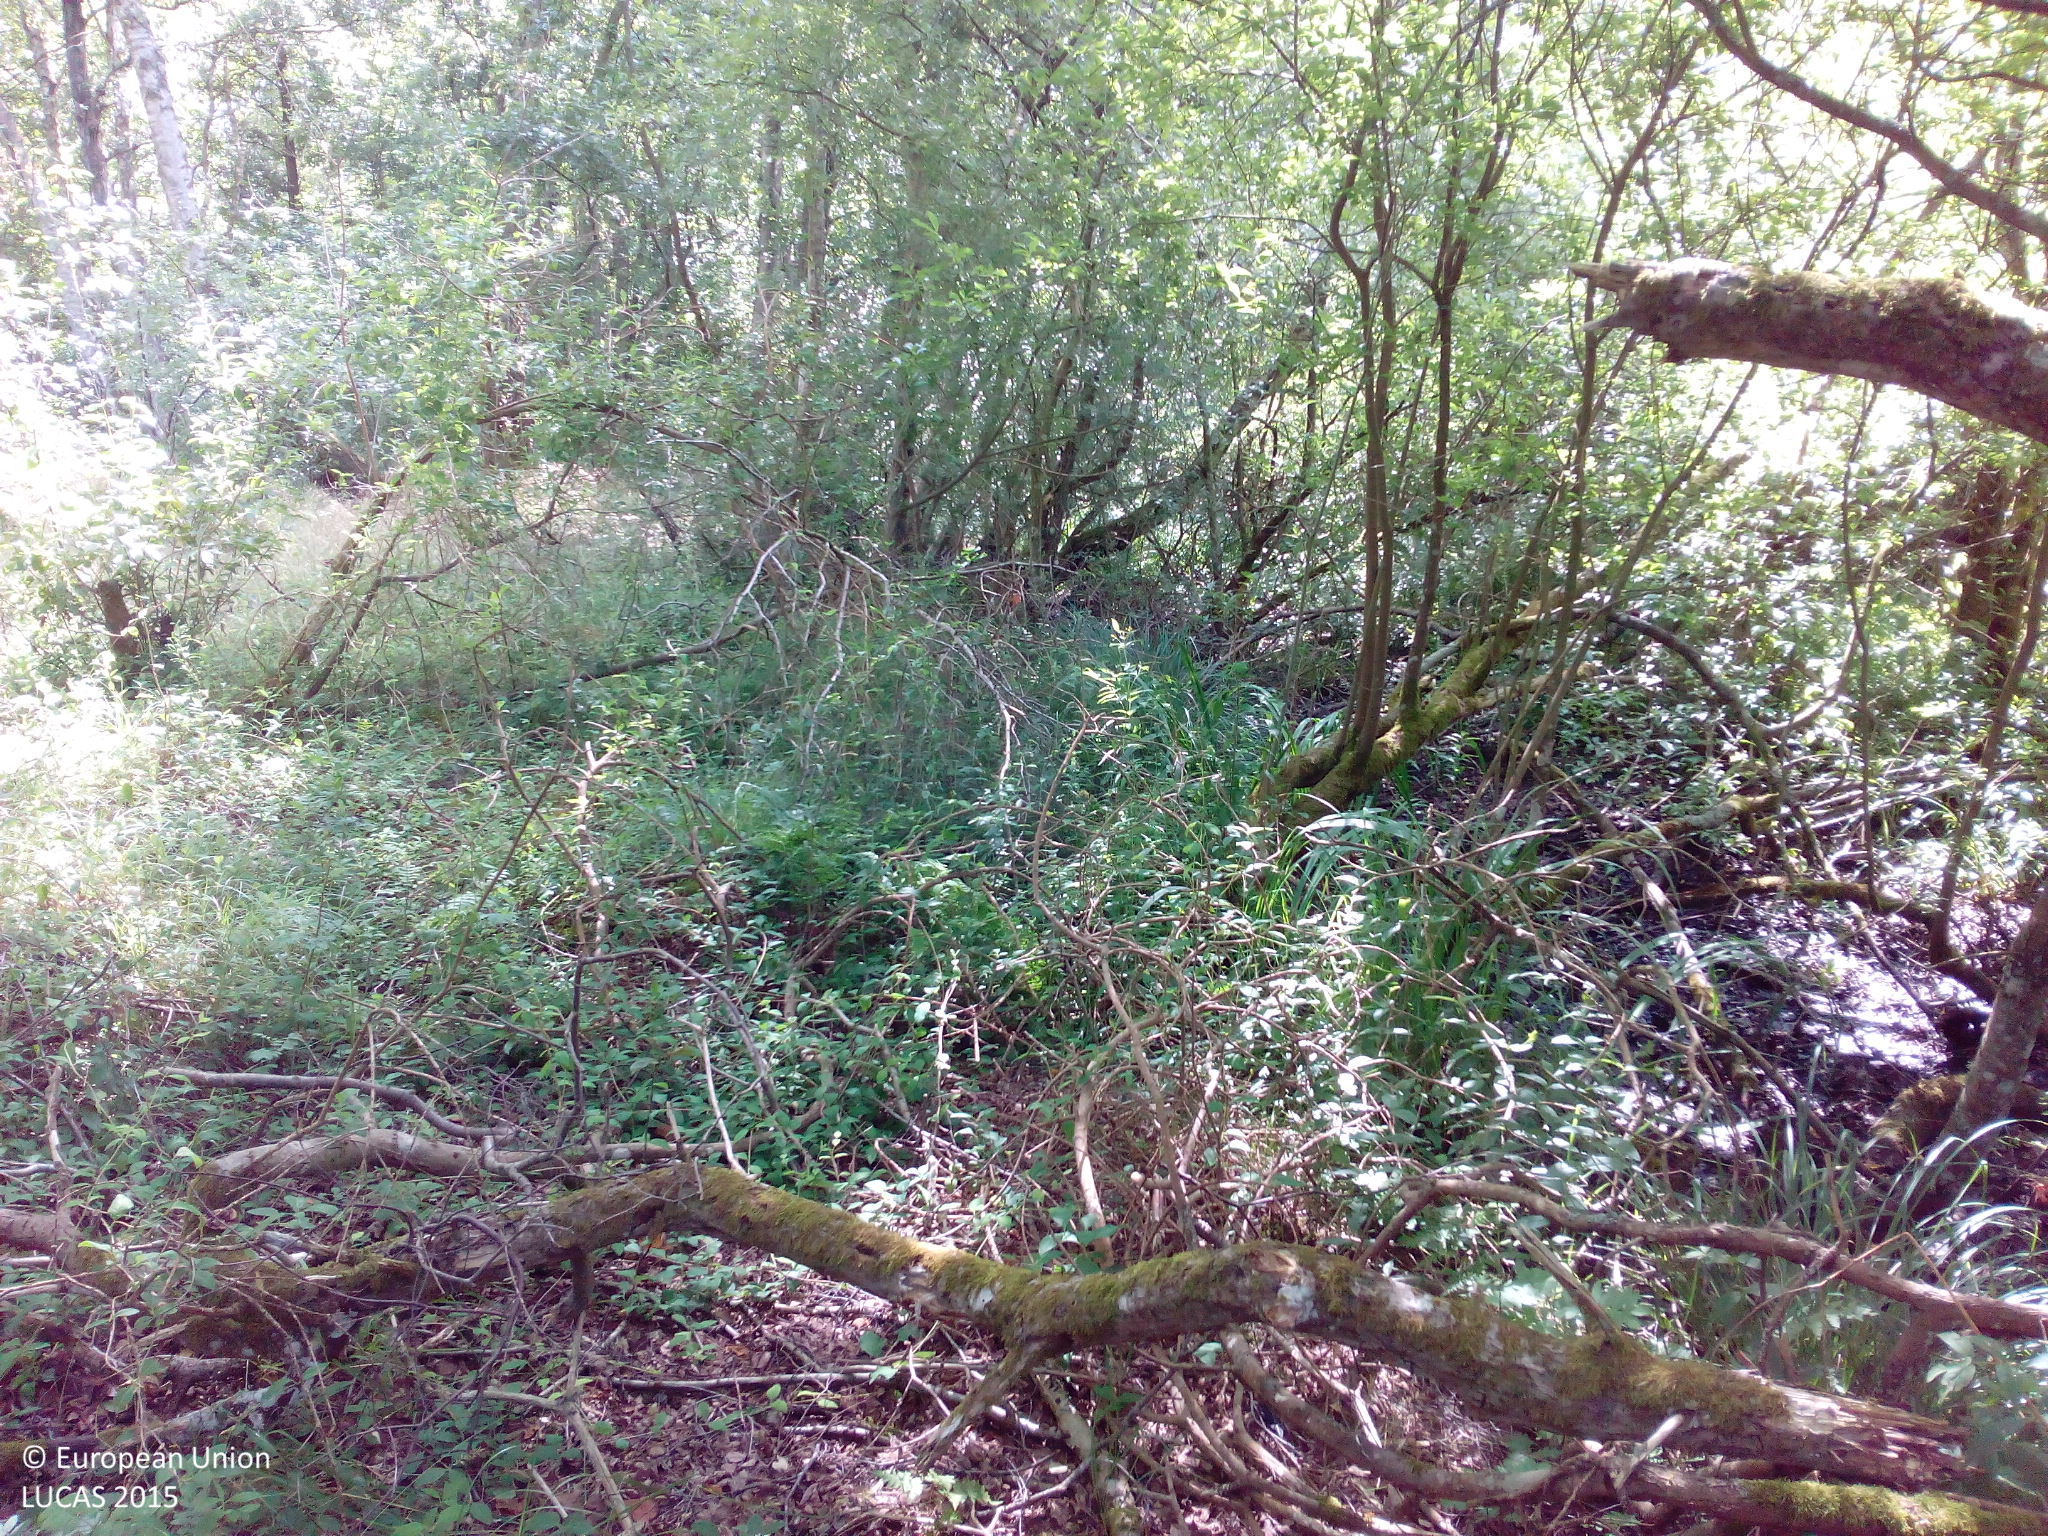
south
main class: Woodland
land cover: Broadleaved woodland
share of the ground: > 75 %
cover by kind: broadleaved forest trees 60 %, herbaceous plants 30 %, shrubs 10 %
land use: Semi-natural and natural areas not in use
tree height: < 5 m
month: July
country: DK
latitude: 56.0093
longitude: 12.0670
